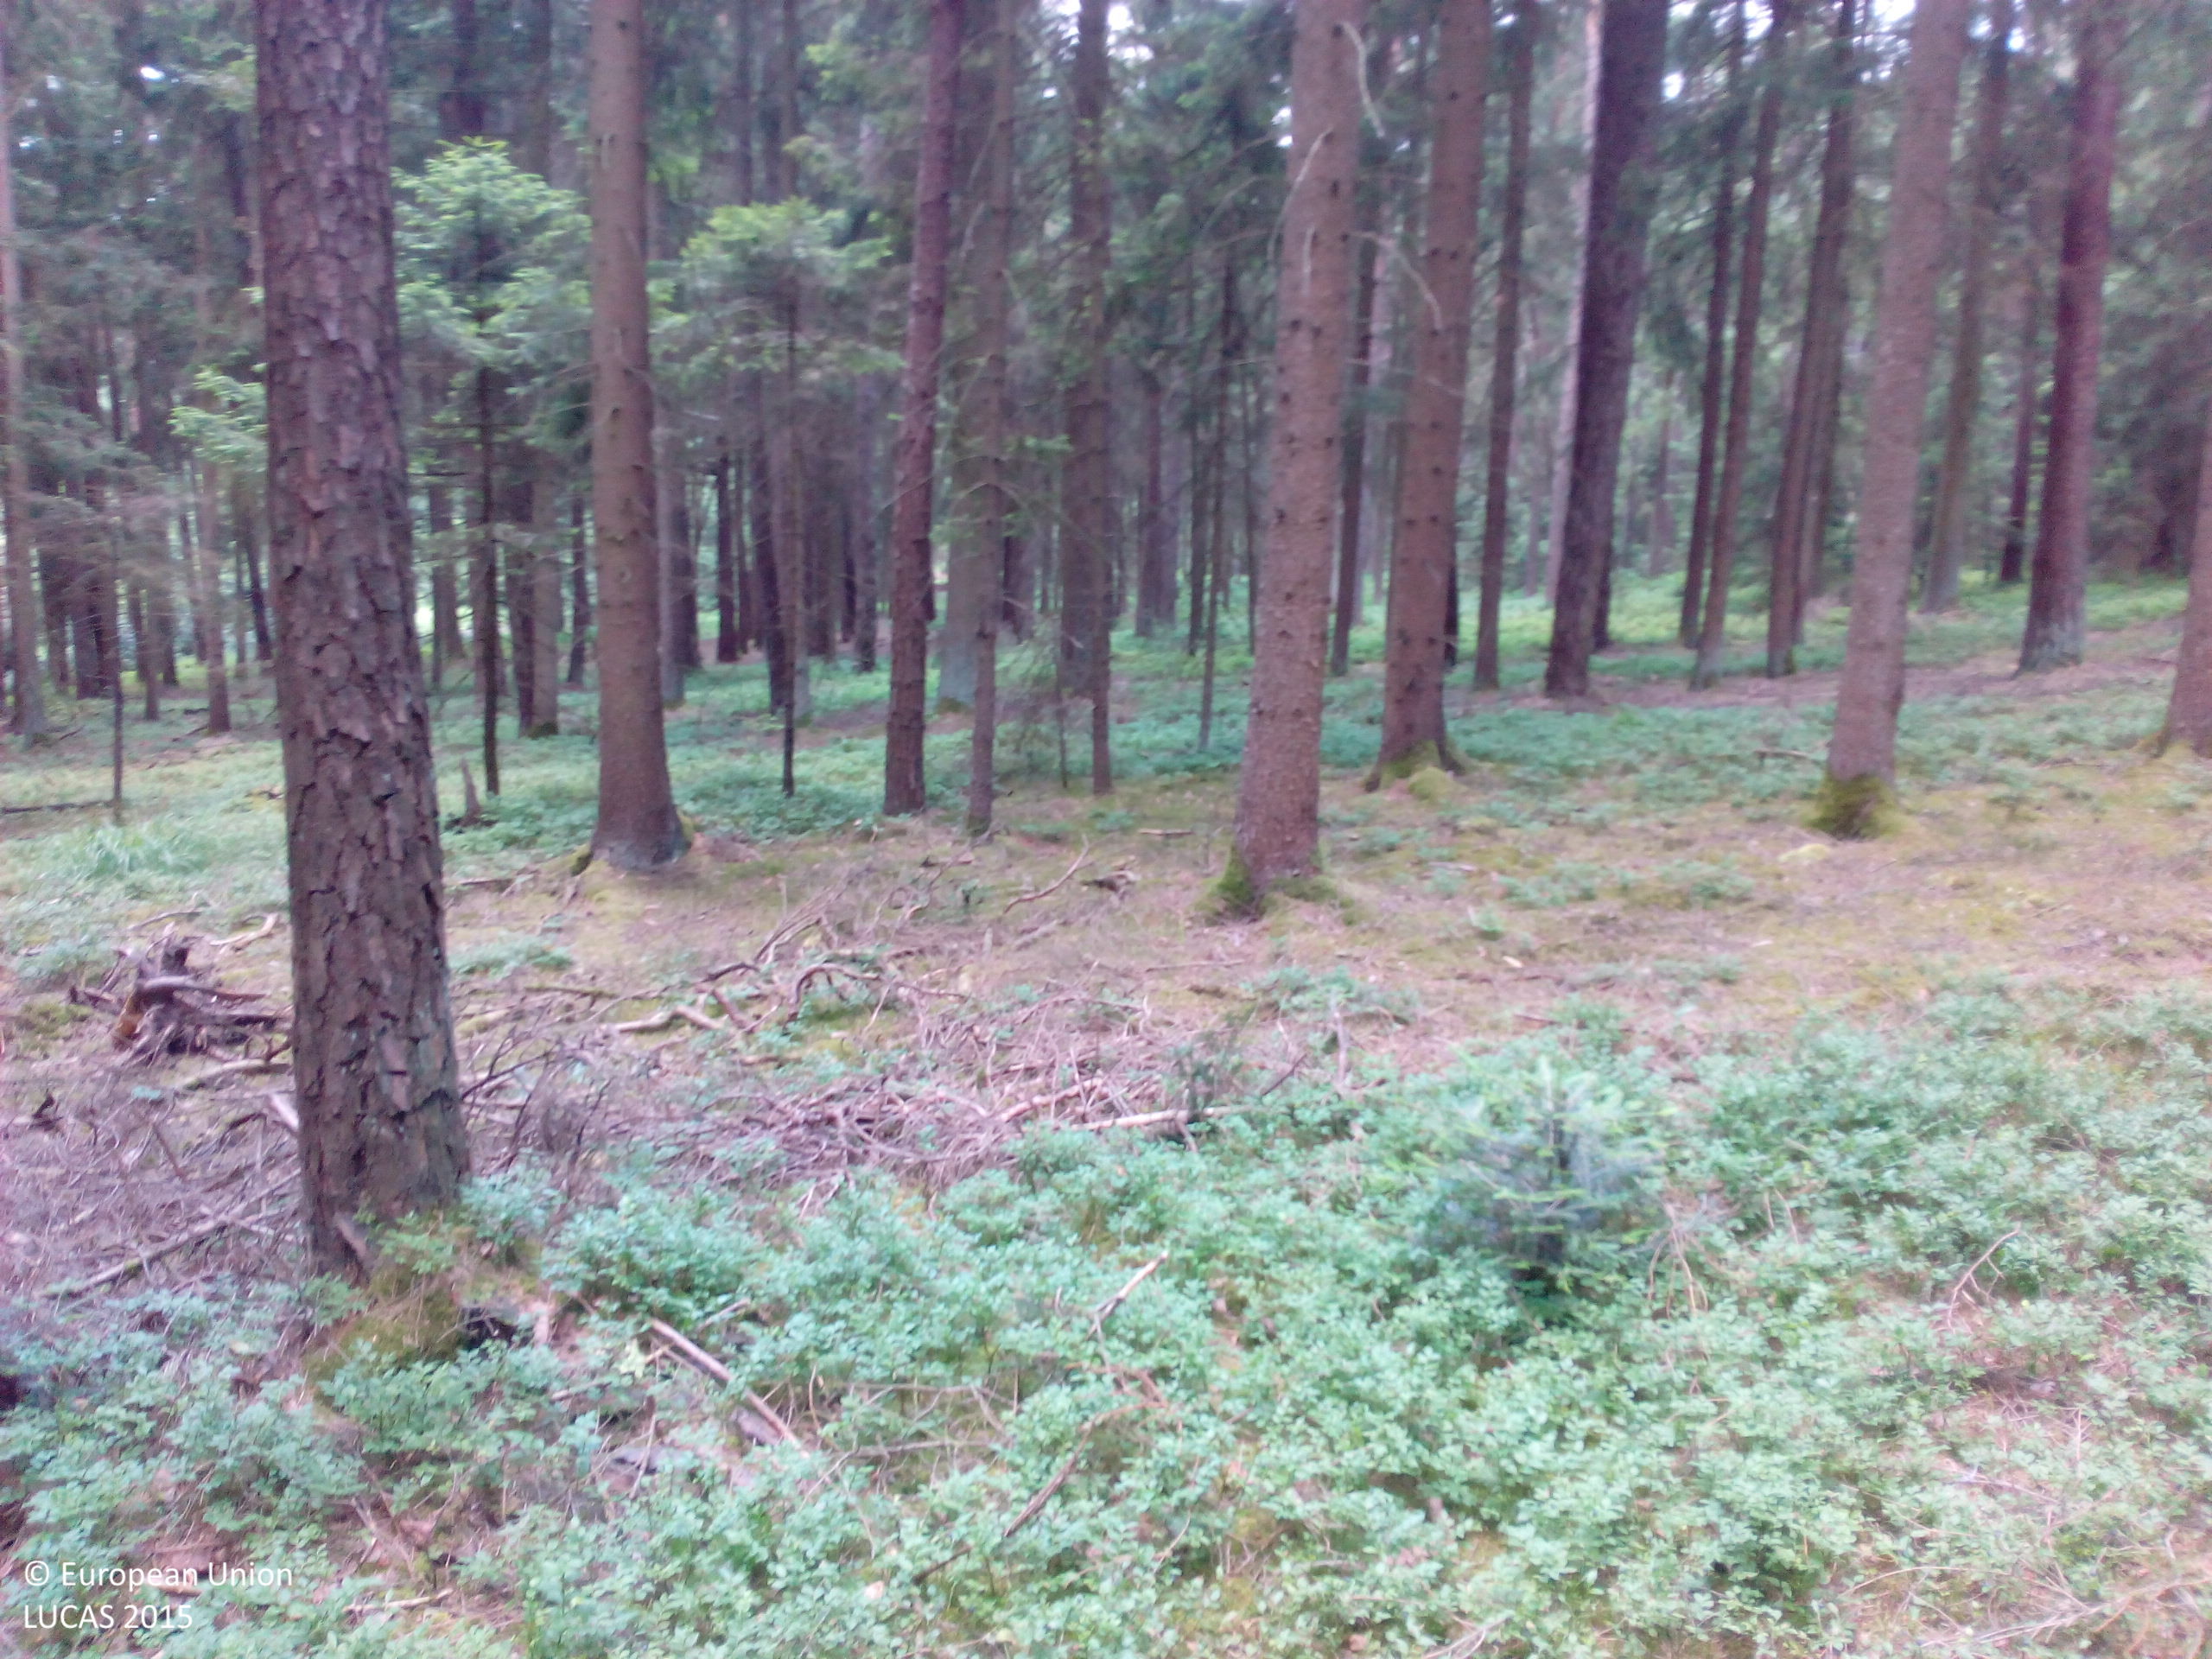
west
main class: Woodland
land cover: Other coniferous woodland
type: hemiboreal forest and nemoral coniferous forest and mixed broadleaved-coniferous forest
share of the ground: 50 - 75 %
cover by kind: coniferous forest trees 55 %, shrubs 20 %, herbaceous plants 10 %, lichens and mosses 10 %, broadleaved forest trees 5 %
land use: Forestry
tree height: > 5 m
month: June
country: DE
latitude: 48.5452
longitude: 12.9116
